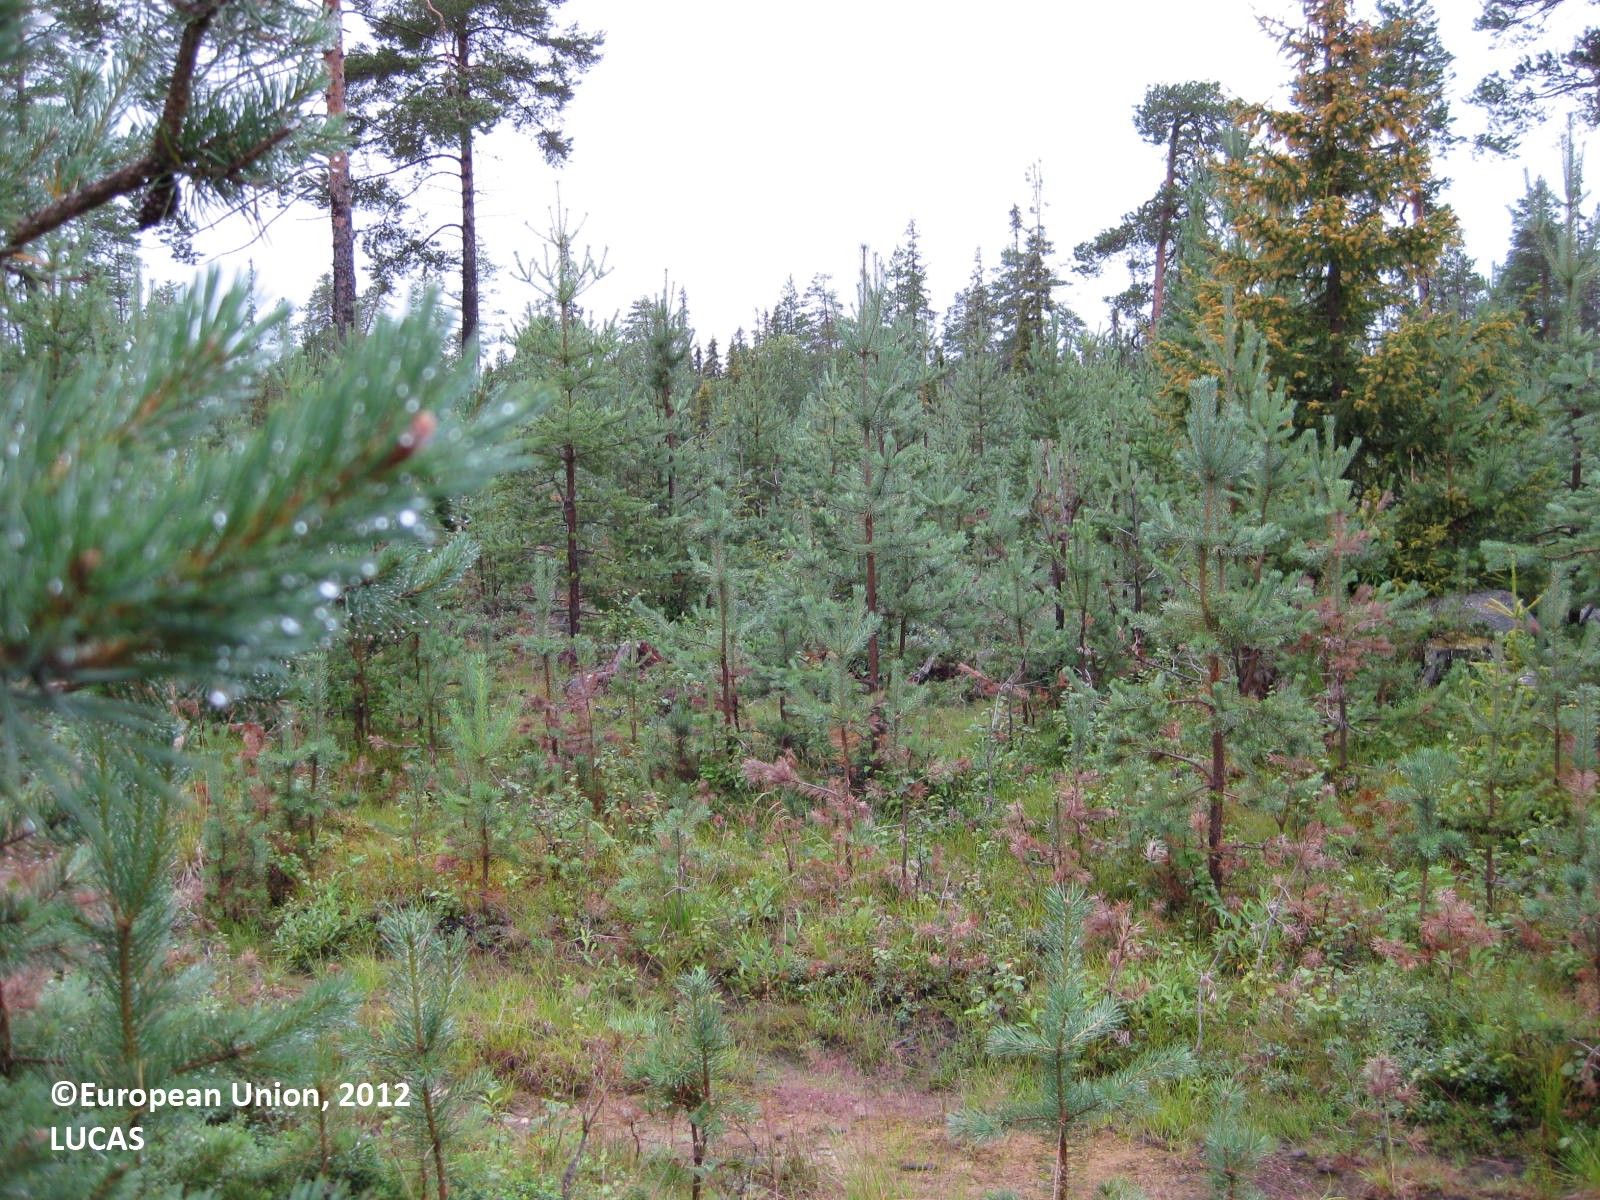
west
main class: Woodland
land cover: Pine dominated coniferous woodland
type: boreal forest
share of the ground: 50 - 75 %
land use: Forestry
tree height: < 5 m
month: August
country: FI
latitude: 65.8325
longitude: 28.2057
